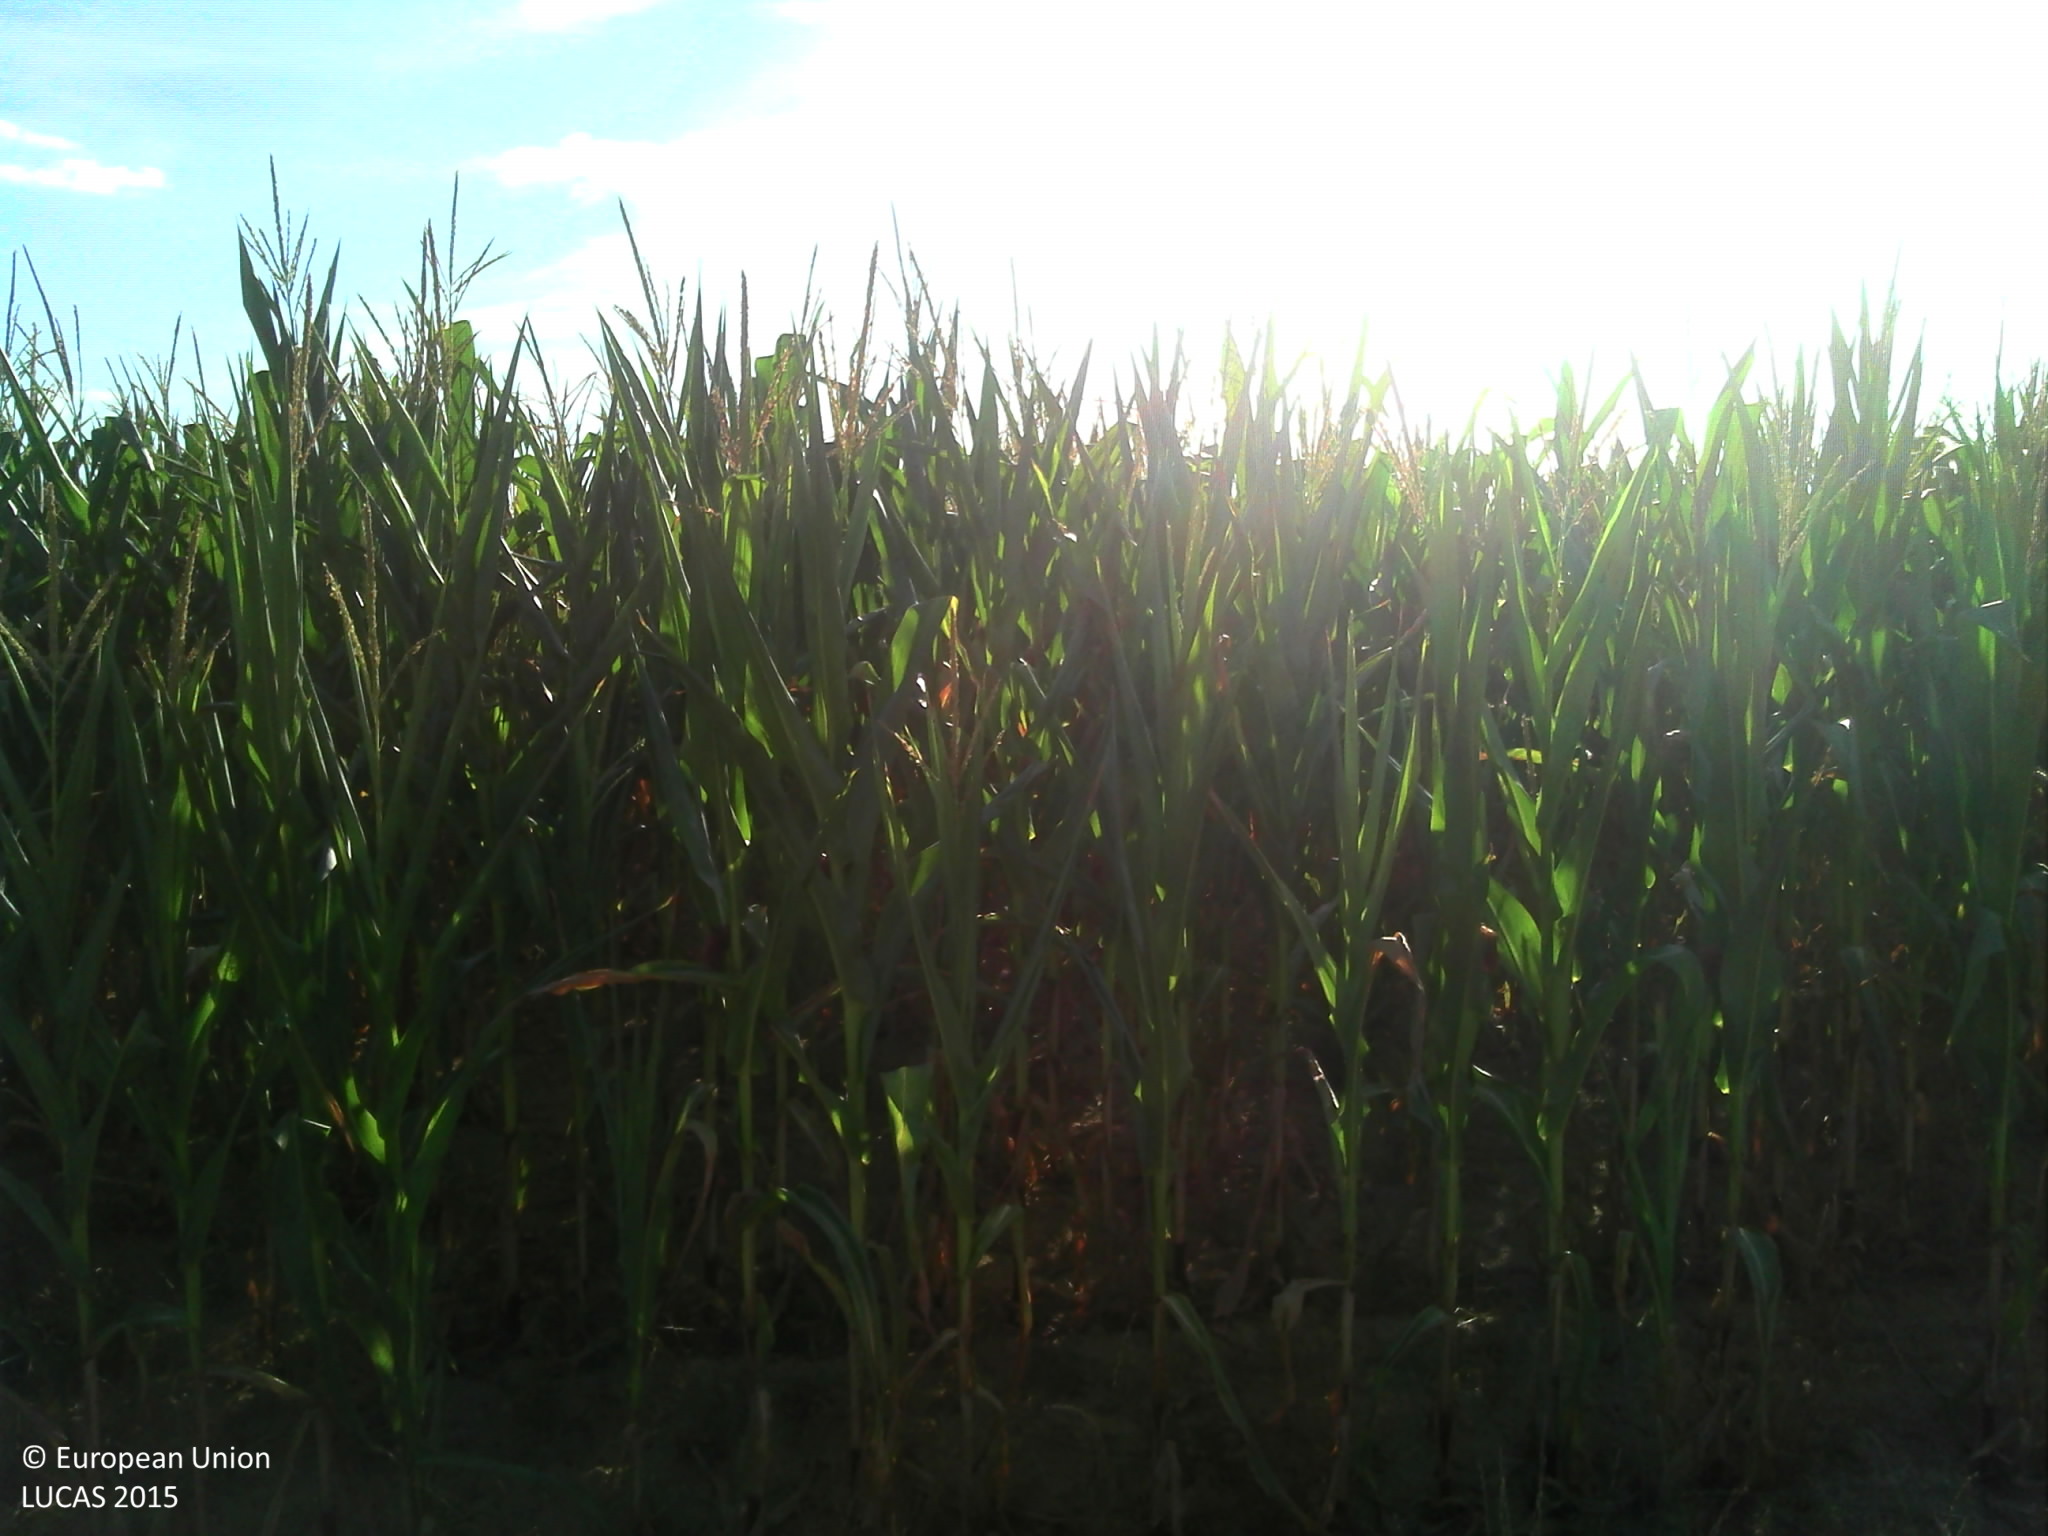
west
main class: Cropland
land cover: Maize
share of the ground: > 75 %
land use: Agriculture (excluding fallow land and kitchen gardens)
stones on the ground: < 10 %
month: July
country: FR
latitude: 47.1803
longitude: 0.7316
